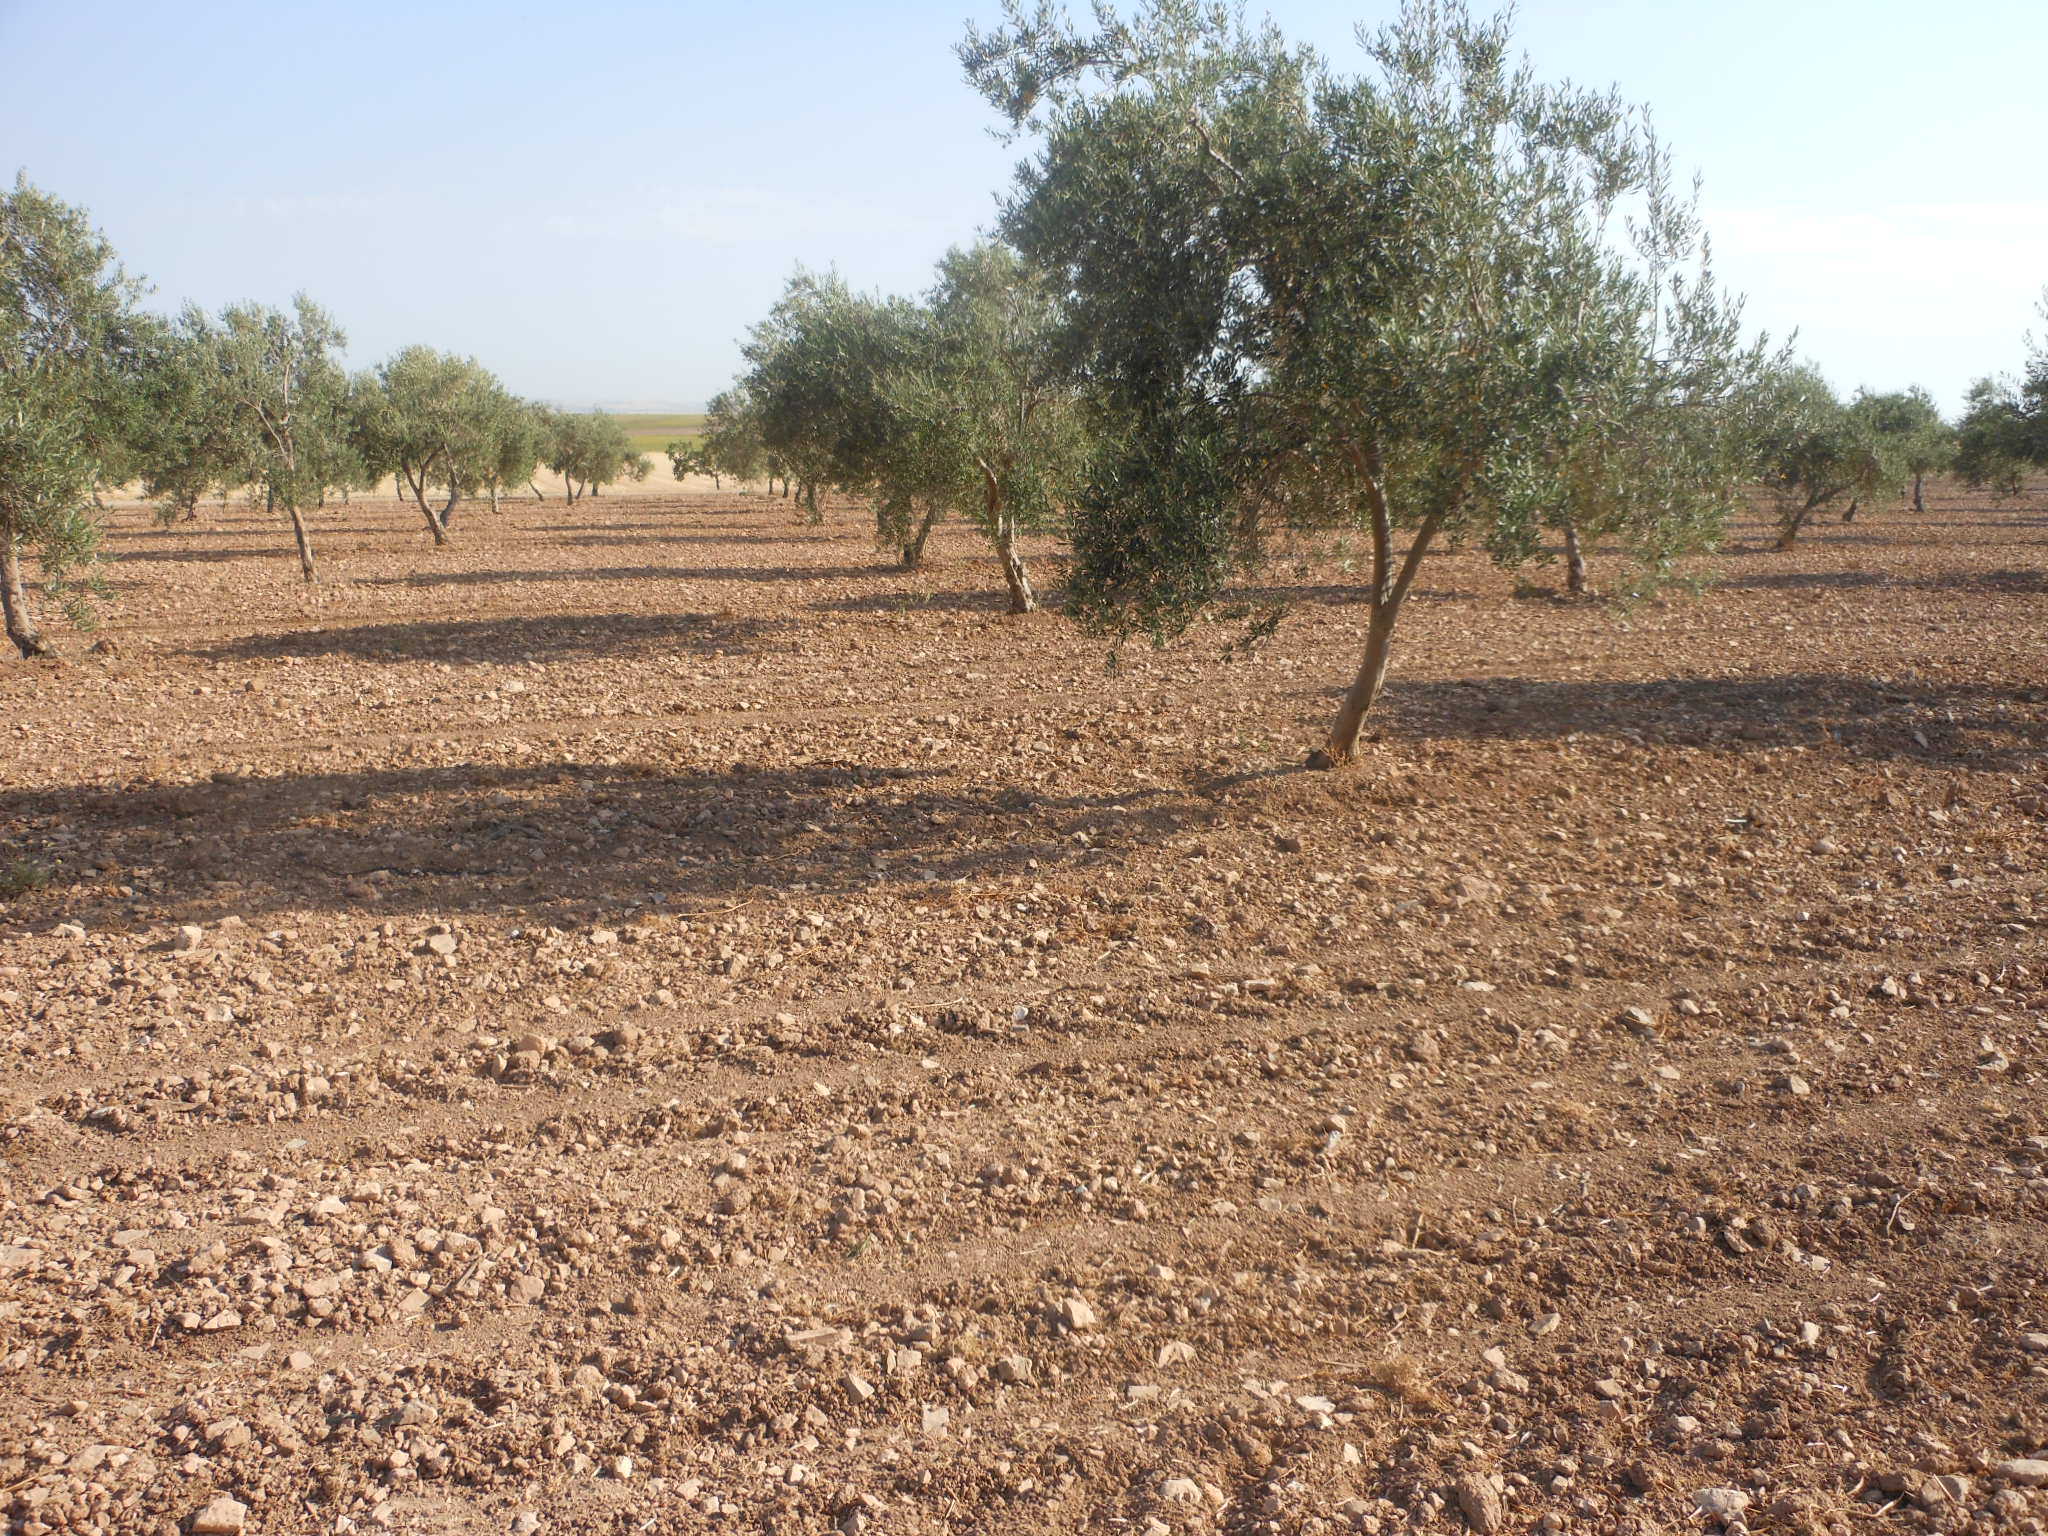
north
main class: Cropland
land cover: Olive groves
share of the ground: 10 - 25 %
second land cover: Other bare soil
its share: > 75 %
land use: Agriculture (excluding fallow land and kitchen gardens)
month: June
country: ES
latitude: 37.2871
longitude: -5.1119
